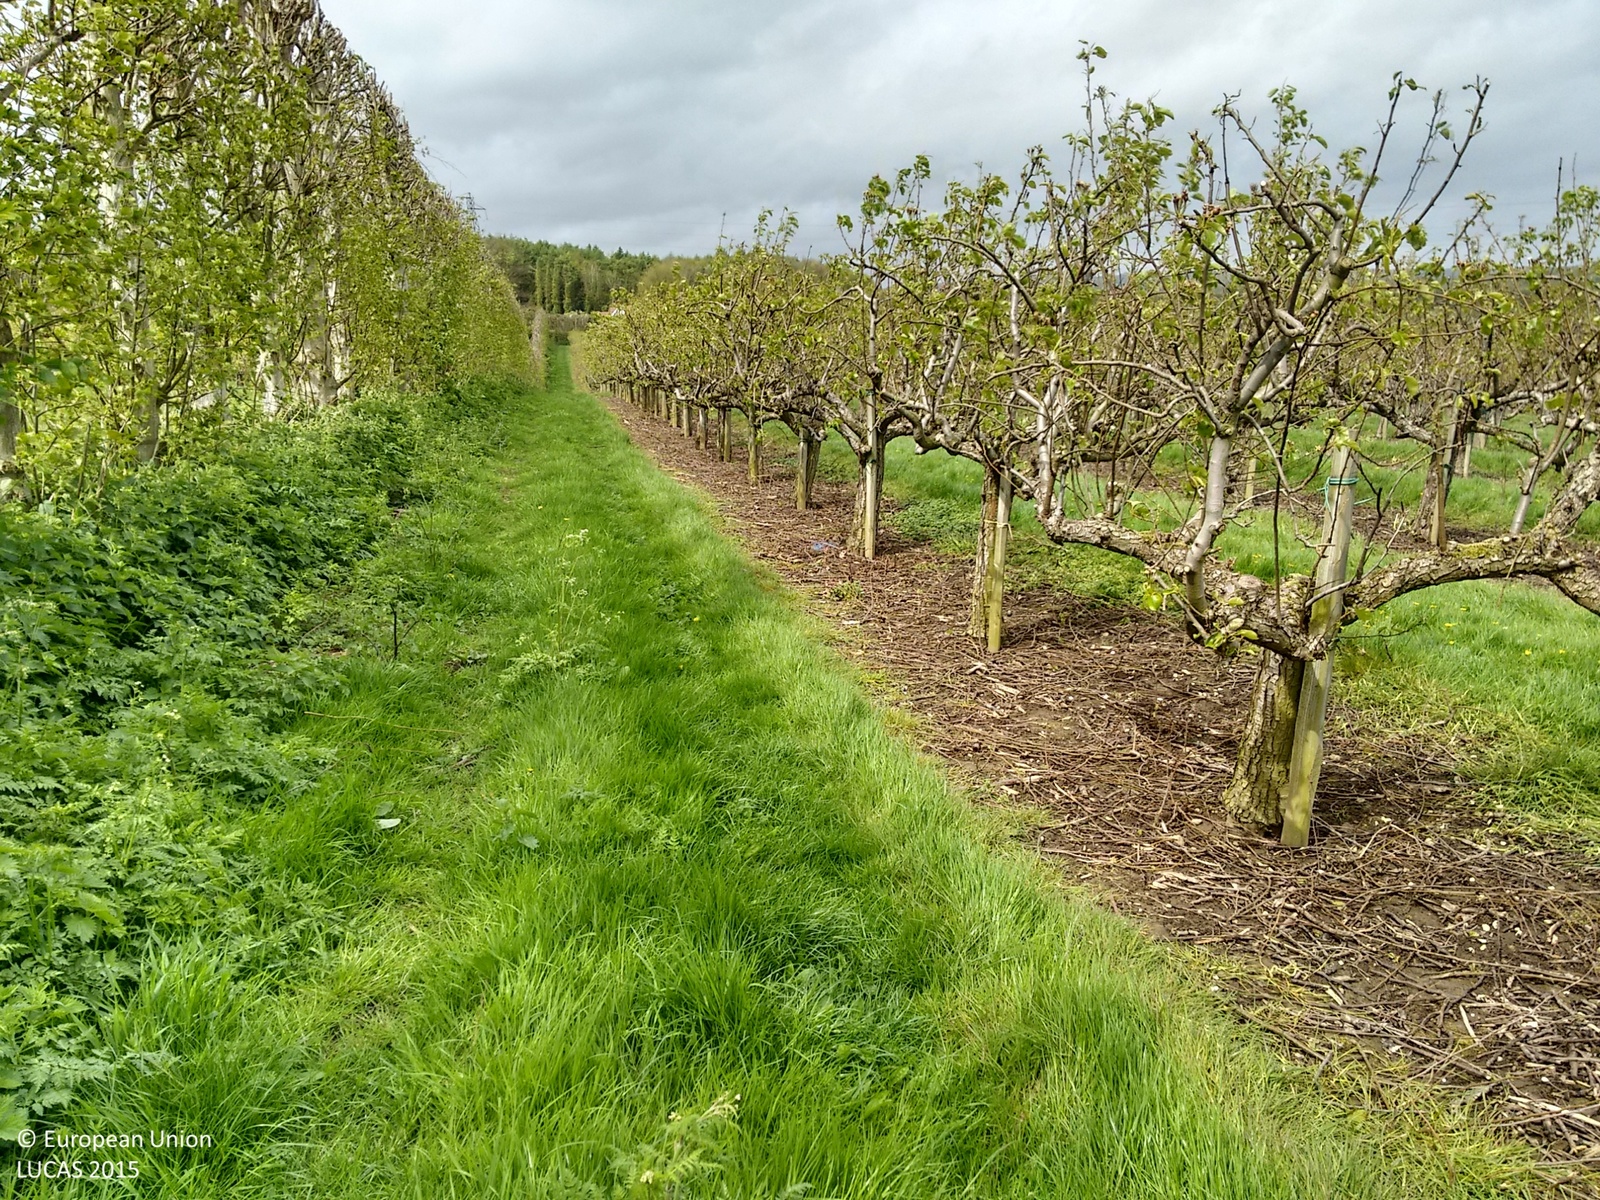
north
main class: Cropland
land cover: Pear fruit
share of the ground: 50 - 75 %
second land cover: Grassland without tree/shrub cover
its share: 50 - 75 %
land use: Agriculture (excluding fallow land and kitchen gardens)
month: May
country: GB
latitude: 51.2726
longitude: 0.2946
